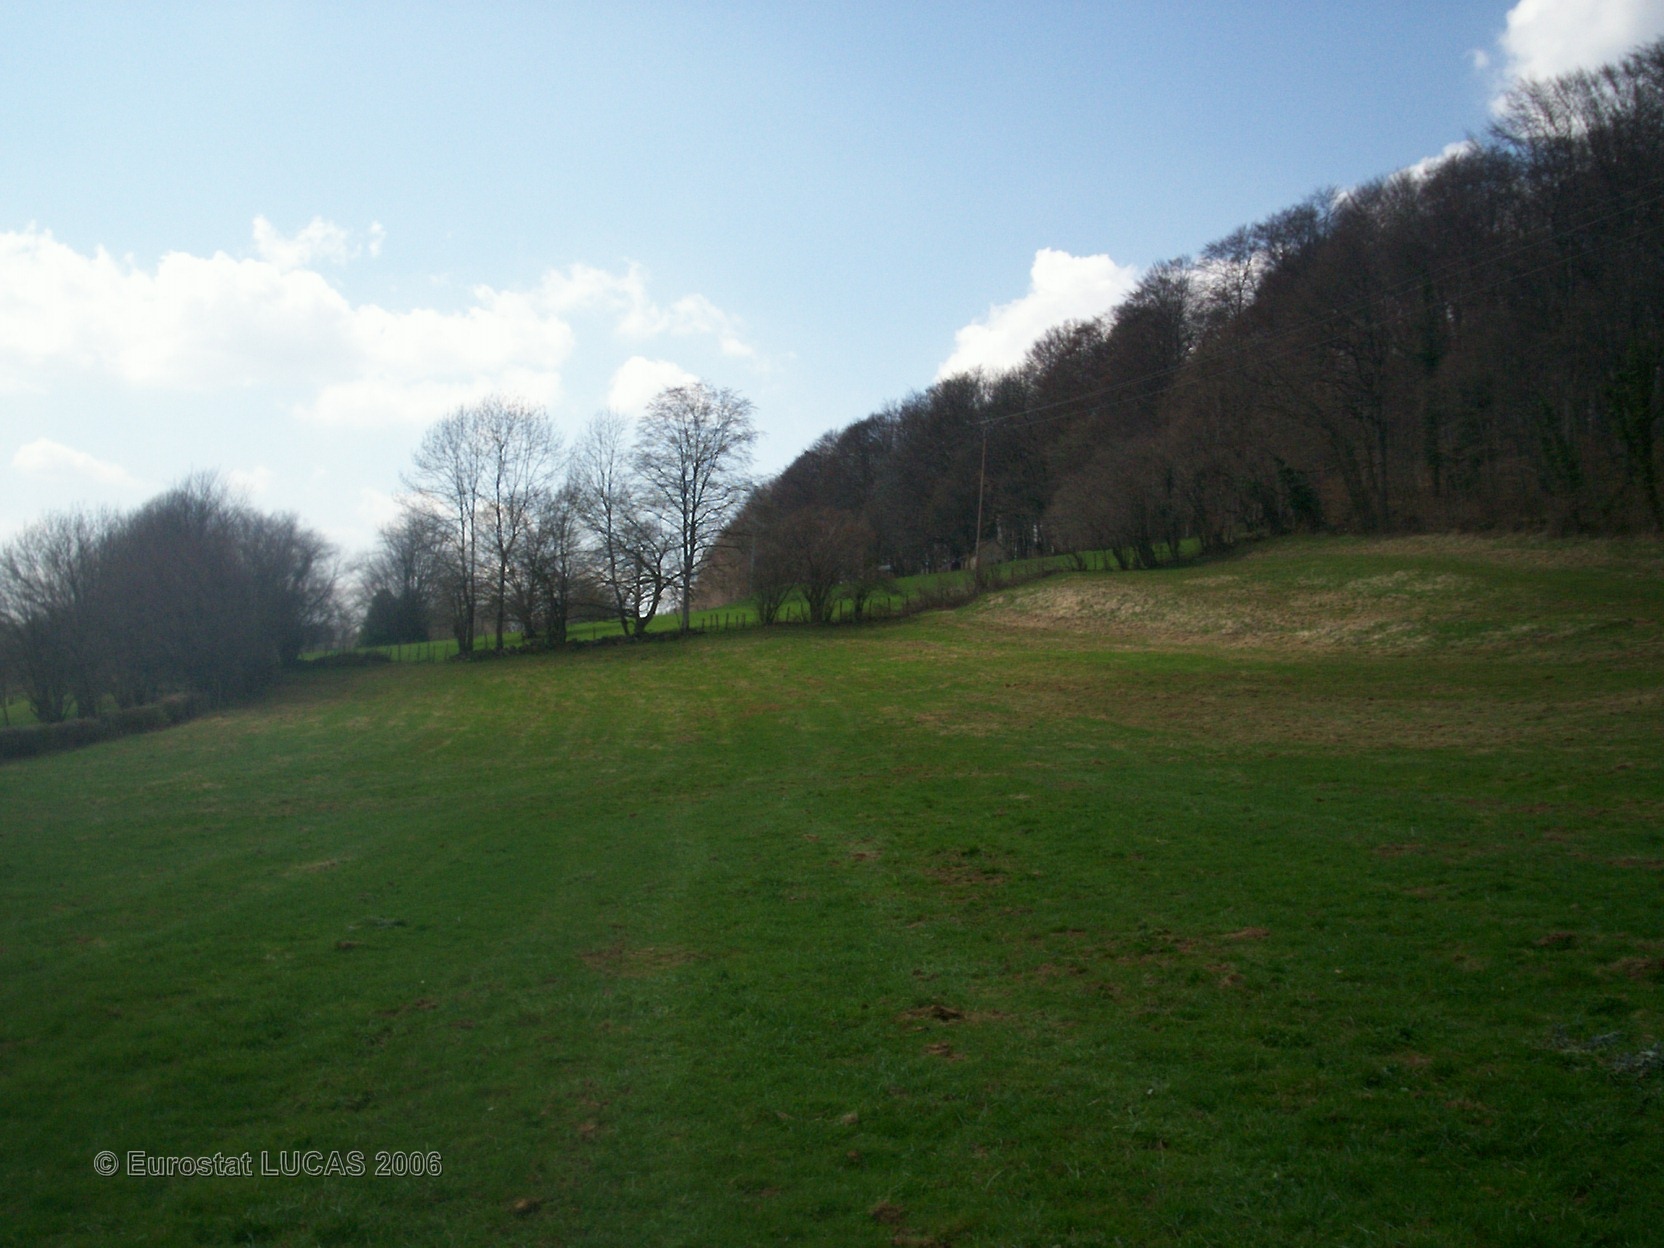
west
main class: Grassland
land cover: Grassland without tree/shrub cover
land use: Agriculture (excluding fallow land and kitchen gardens)
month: April
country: FR
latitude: 47.3497
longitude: 6.8381
